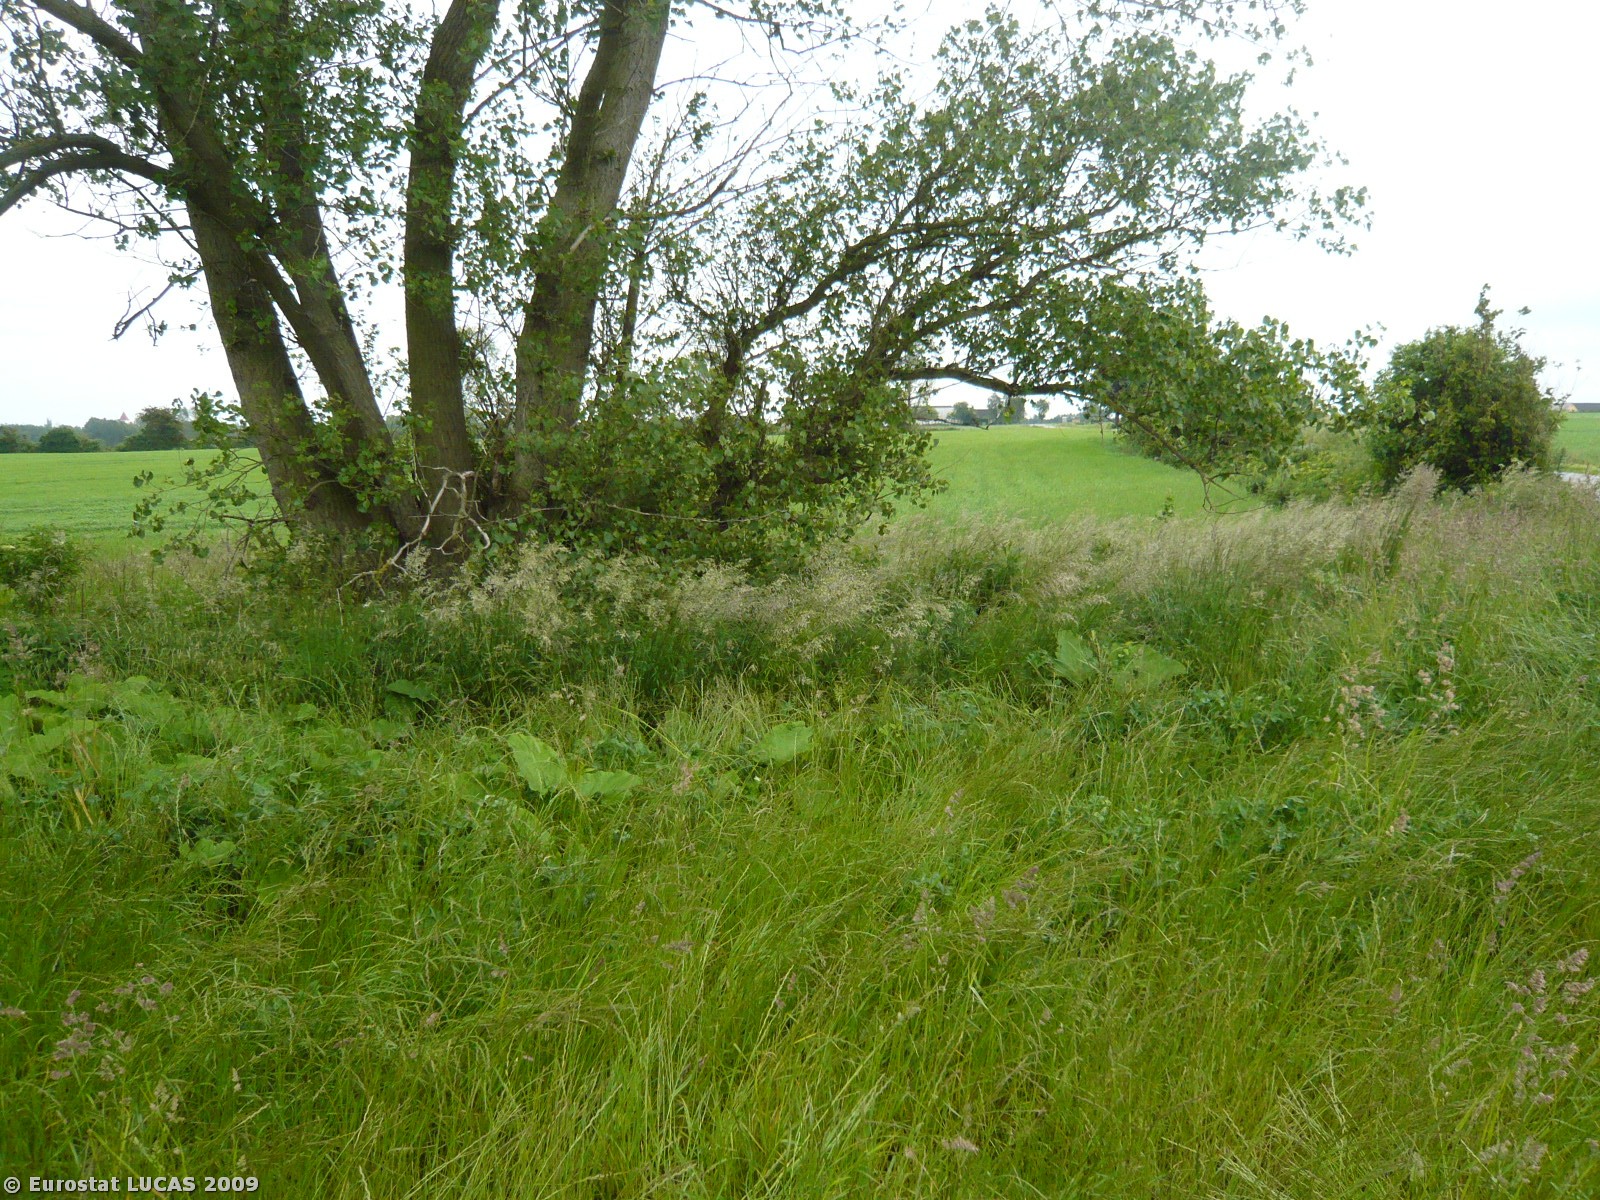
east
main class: Grassland
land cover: Grassland without tree/shrub cover
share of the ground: > 75 %
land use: Agriculture (excluding fallow land and kitchen gardens)
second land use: Road transport
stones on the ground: < 10 %
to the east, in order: Grassland without tree/shrub cover; Tracks; Ditches and canals; Broadleaved woodland; Barley; Shrubland with sparse tree cover; Temporary grasslands
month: June
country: DK
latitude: 54.7555
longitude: 11.7547
